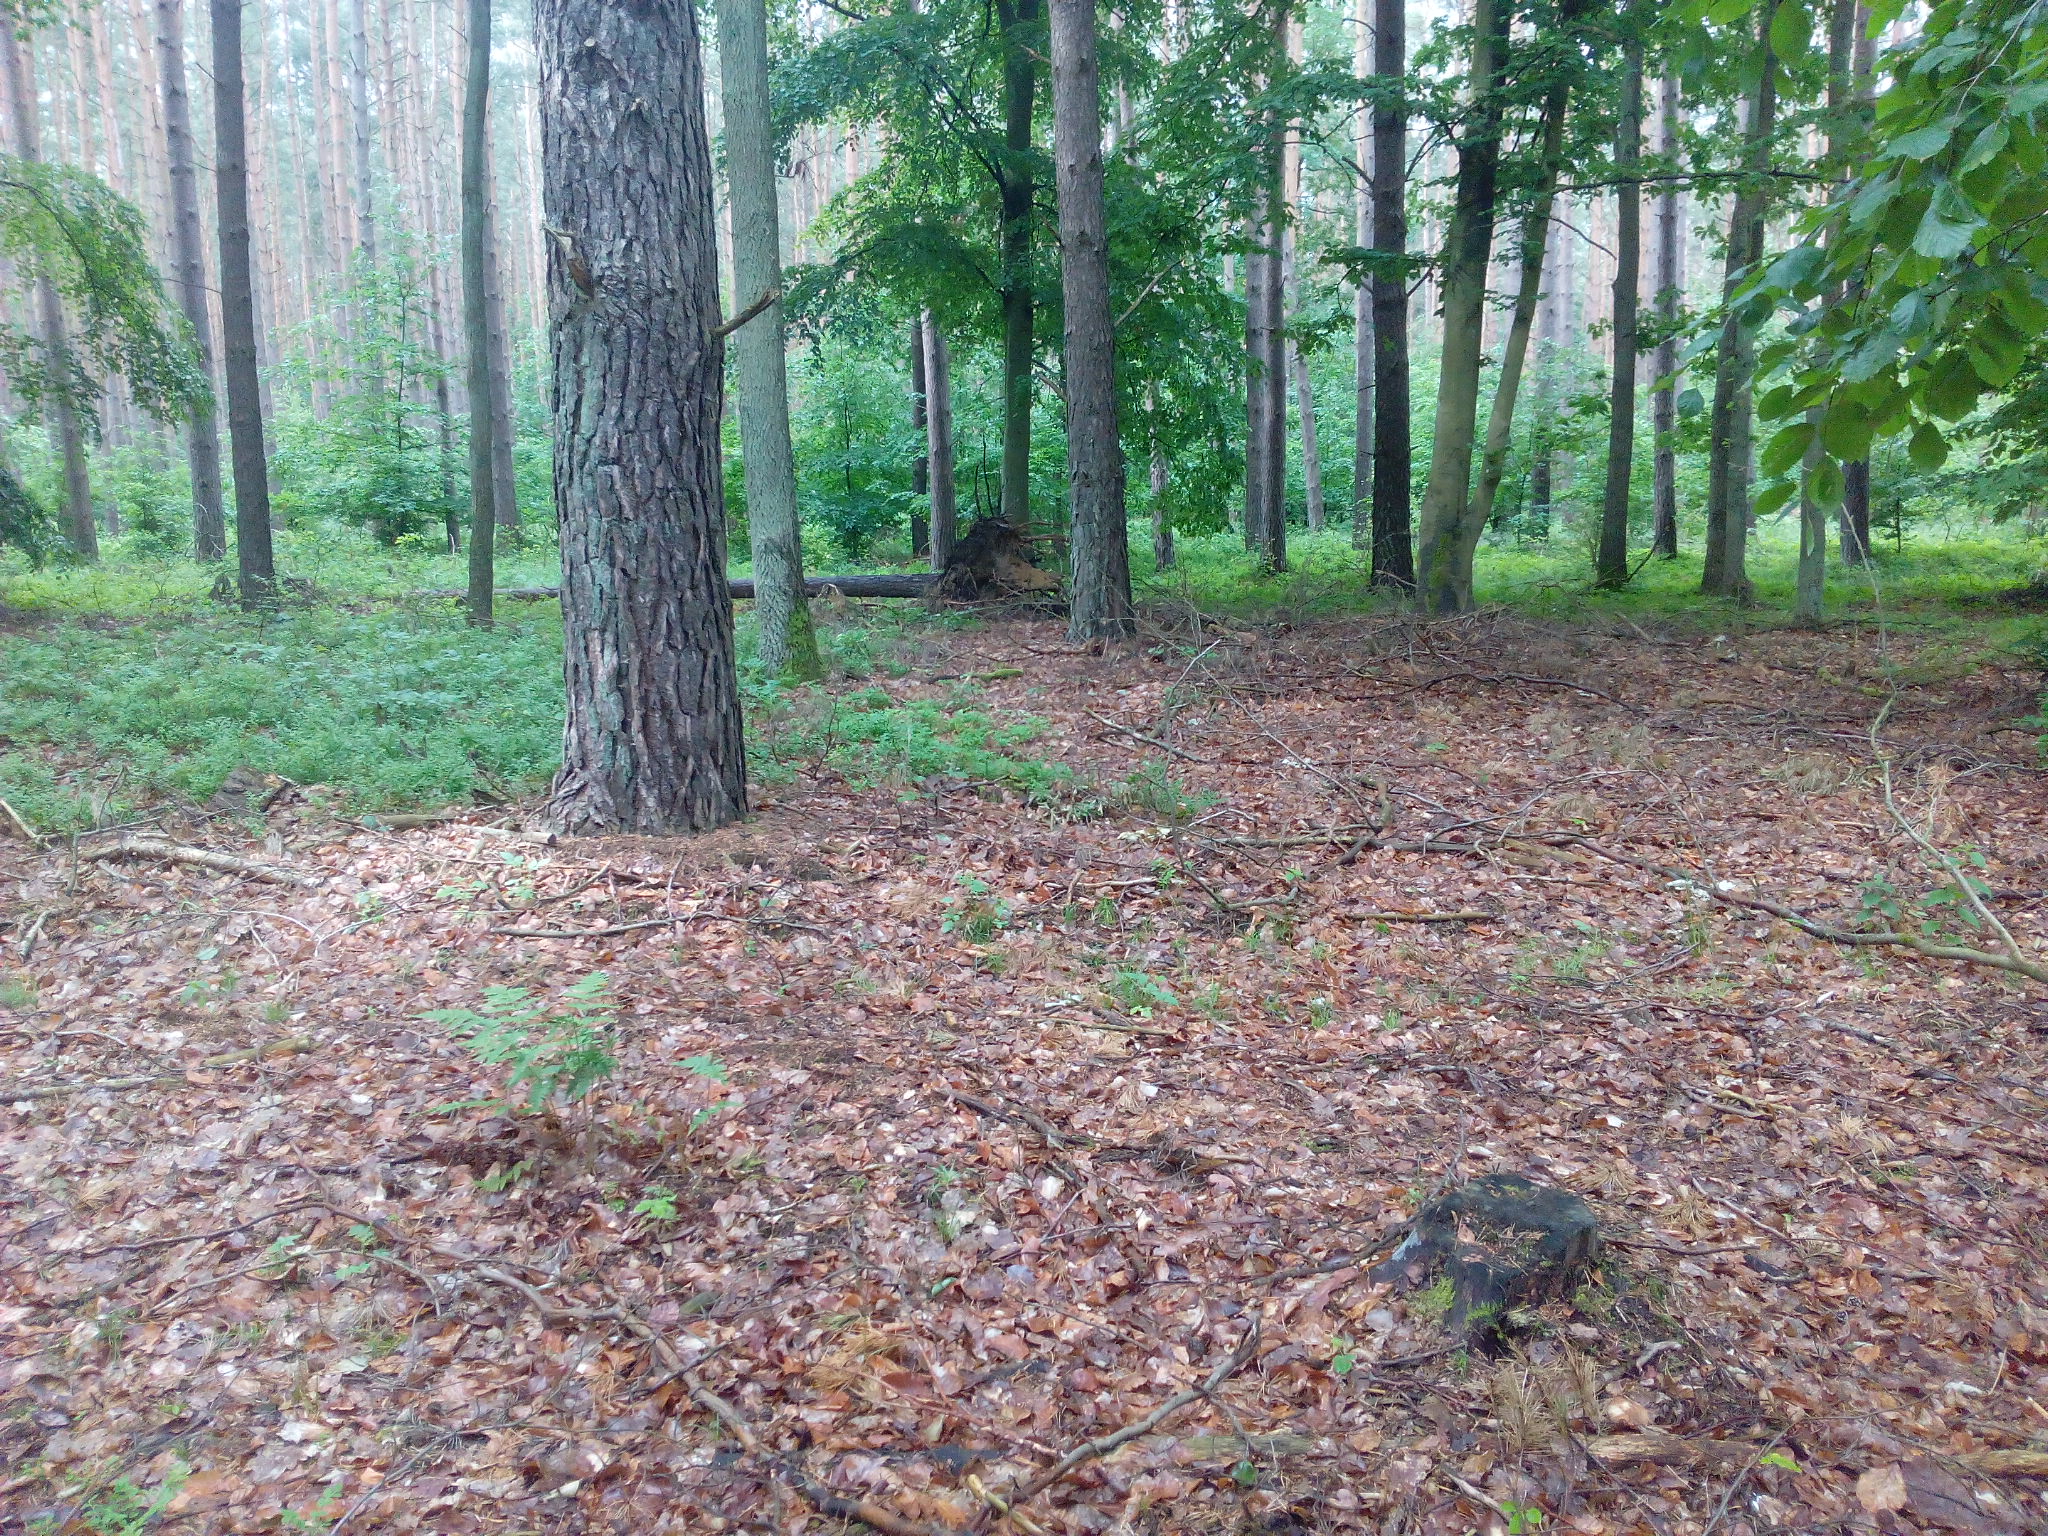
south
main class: Woodland
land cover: Other mixed woodland
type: hemiboreal forest and nemoral coniferous forest and mixed broadleaved-coniferous forest
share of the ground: 50 - 75 %
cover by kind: coniferous forest trees 40 %, broadleaved forest trees 30 %, herbaceous plants 20 %, unconsolidated bare surface 10 %
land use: Forestry
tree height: > 5 m
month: June
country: DE
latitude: 53.3058
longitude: 13.1961
